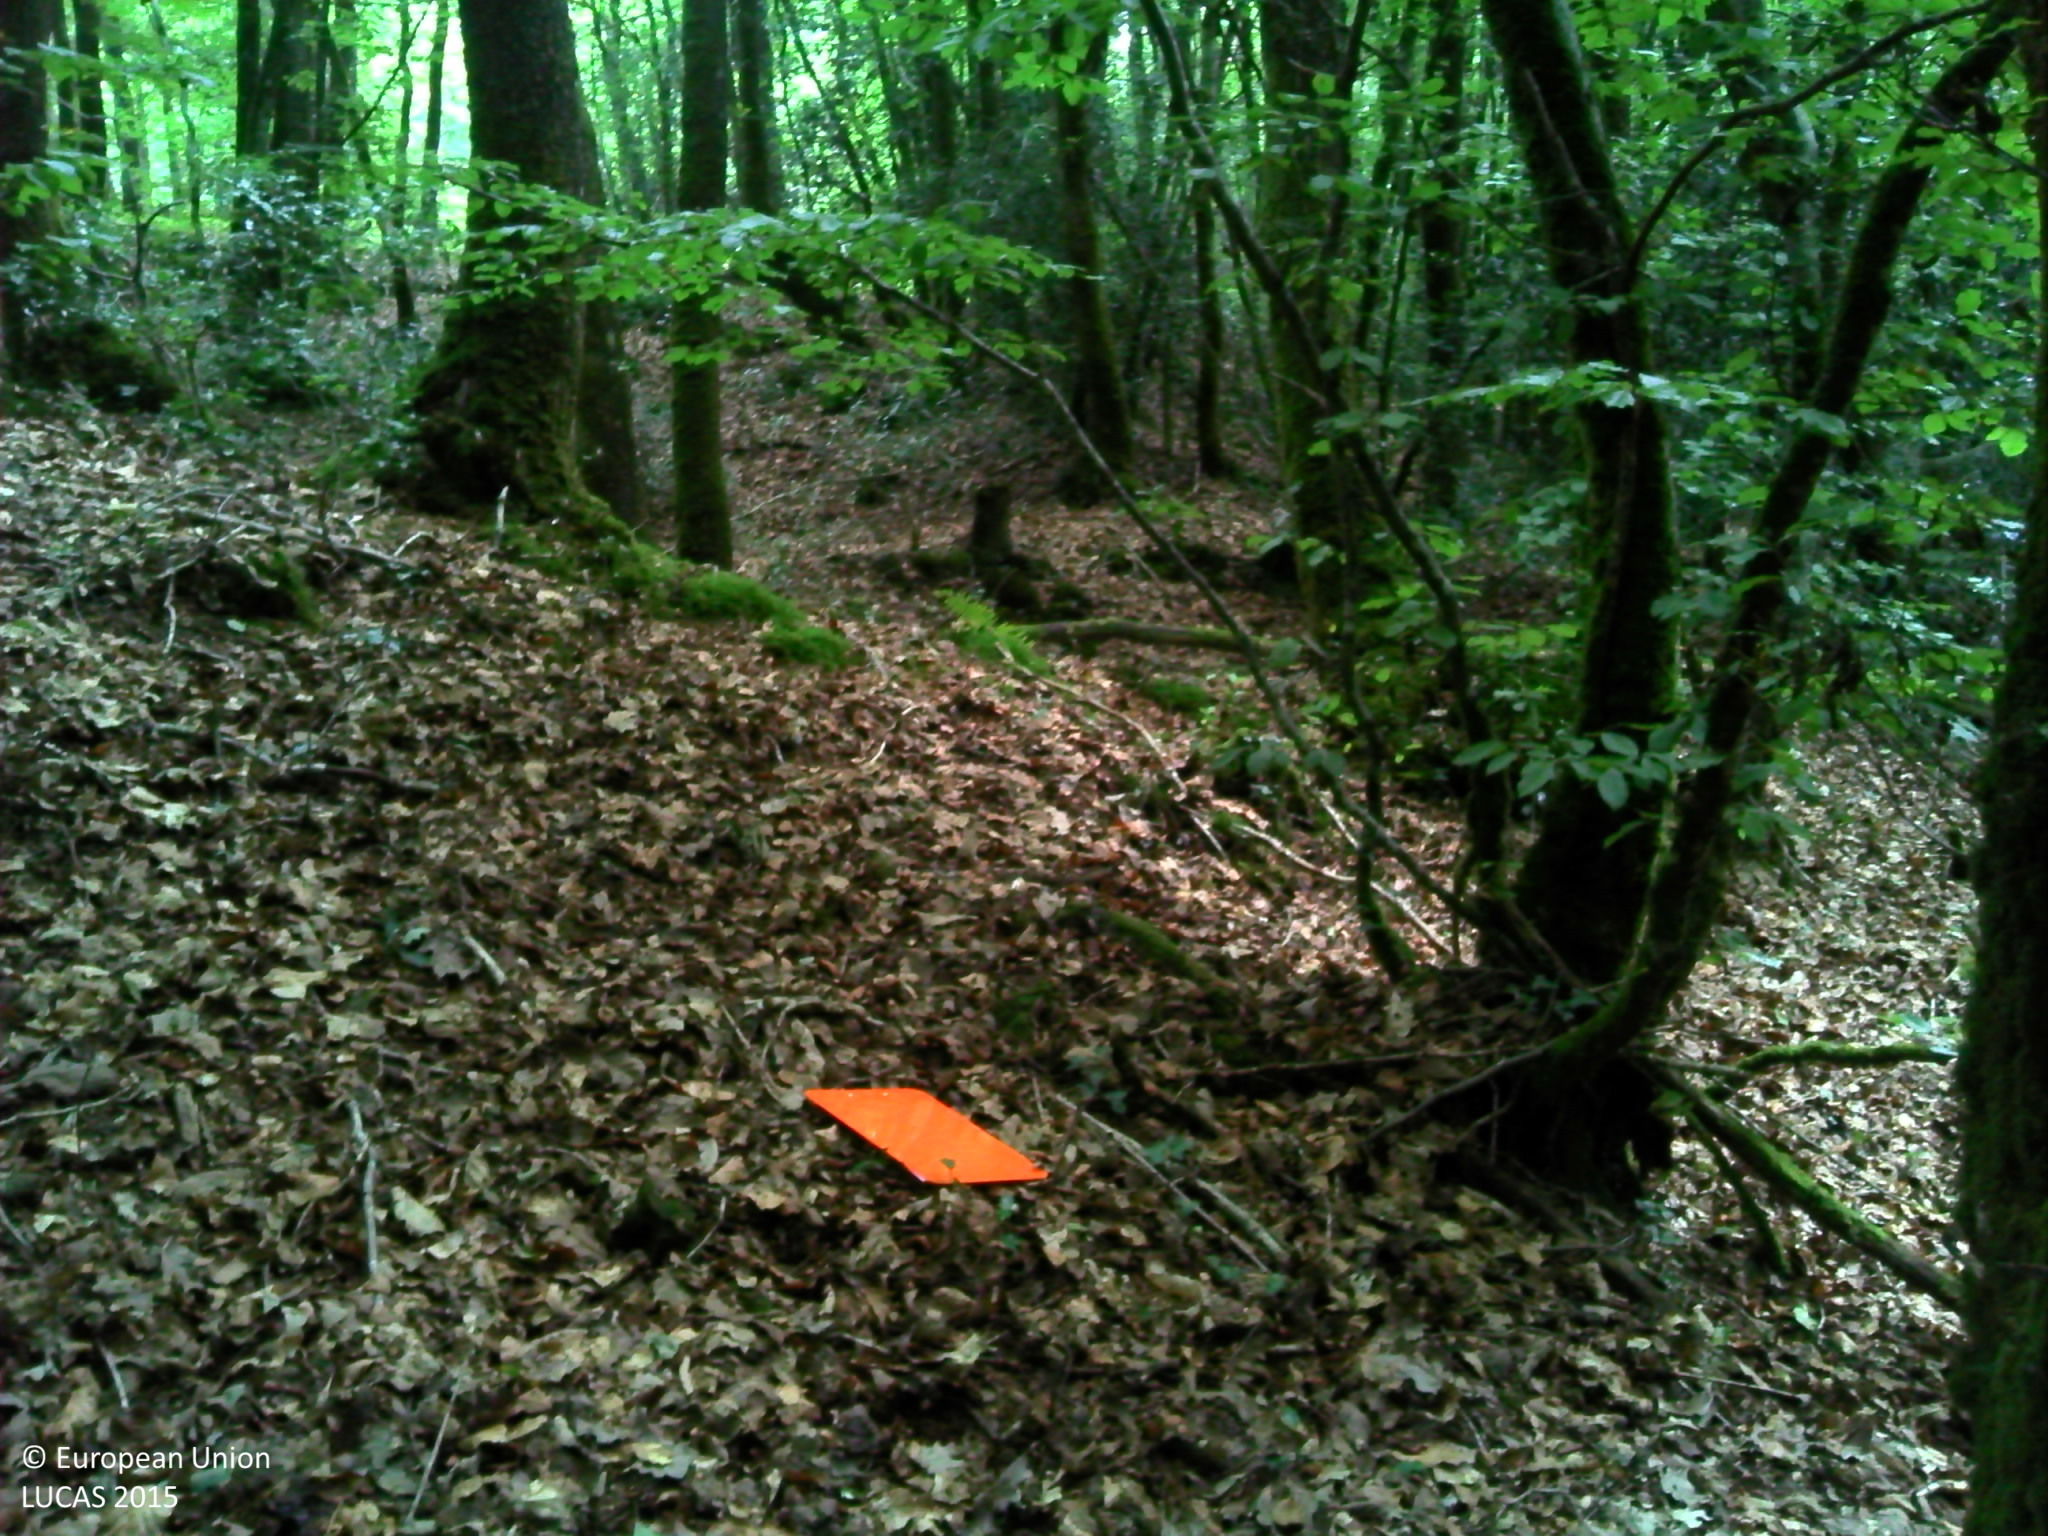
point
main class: Woodland
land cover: Broadleaved woodland
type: acidophilous oak and oak-birch forest
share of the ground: > 75 %
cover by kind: broadleaved forest trees 80 %, shrubs 10 %, herbaceous plants 10 %
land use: Forestry
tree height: > 5 m
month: August
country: FR
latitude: 48.3499
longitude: -3.3949
